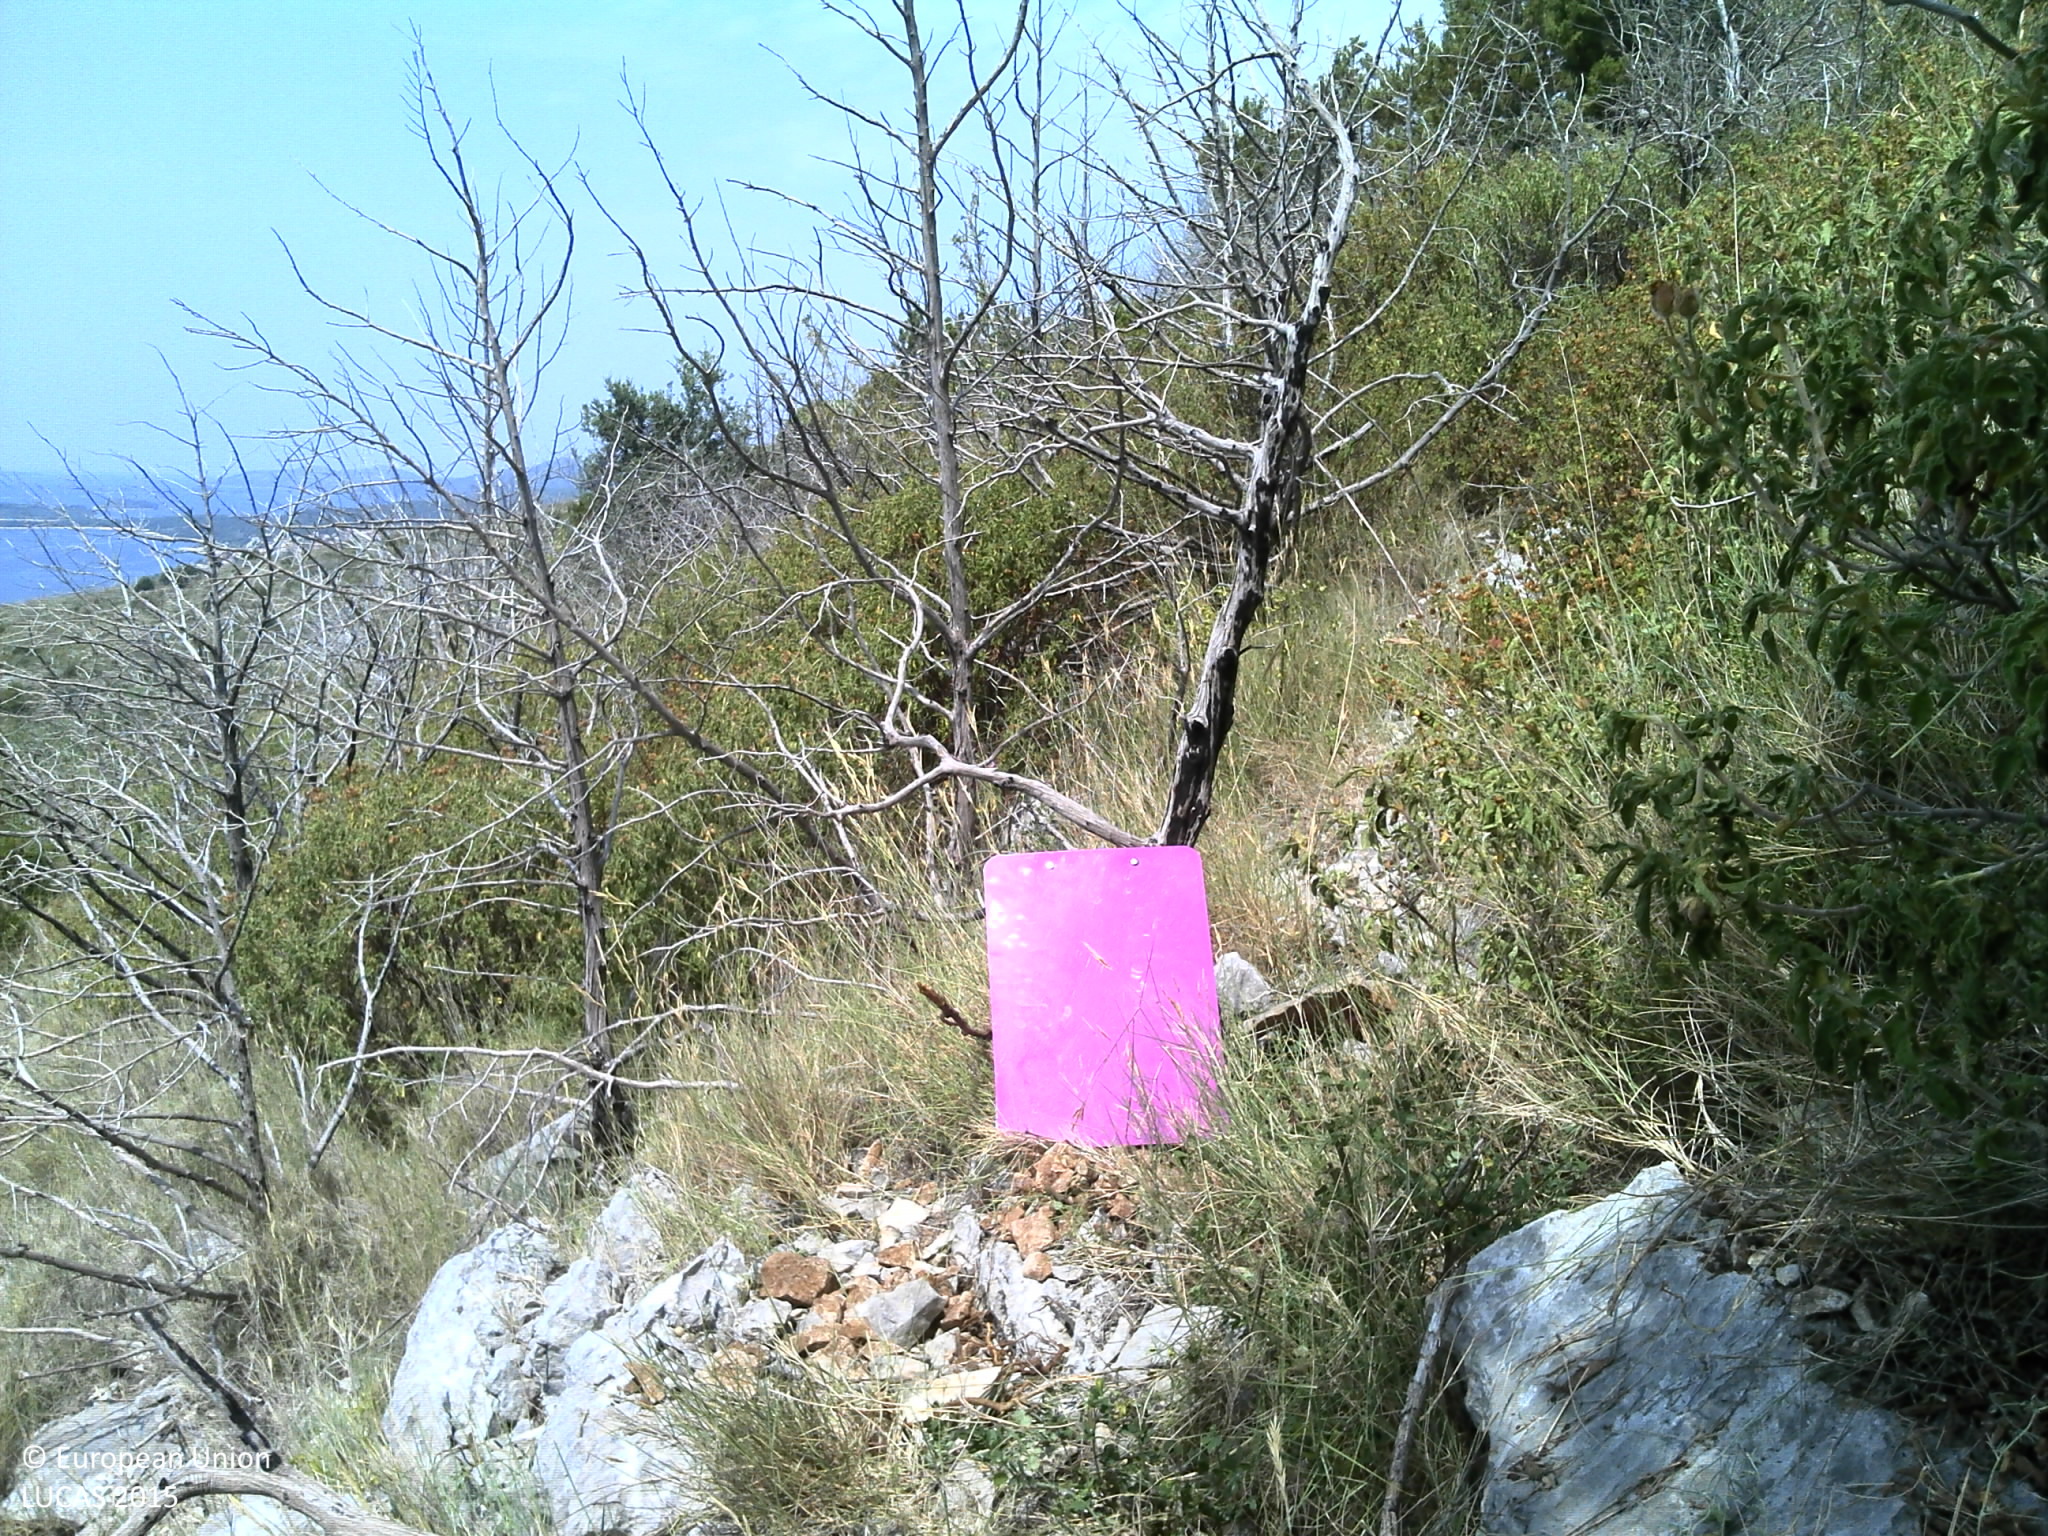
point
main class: Shrubland
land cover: Shrubland with sparse tree cover
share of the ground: 25 - 50 %
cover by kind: shrubs 35 %, herbaceous plants 30 %, consolidated bare surface 20 %, unconsolidated bare surface 10 %, broadleaved forest trees 5 %
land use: Abandoned areas
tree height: < 5 m
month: June
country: HR
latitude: 43.4891
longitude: 16.3092
